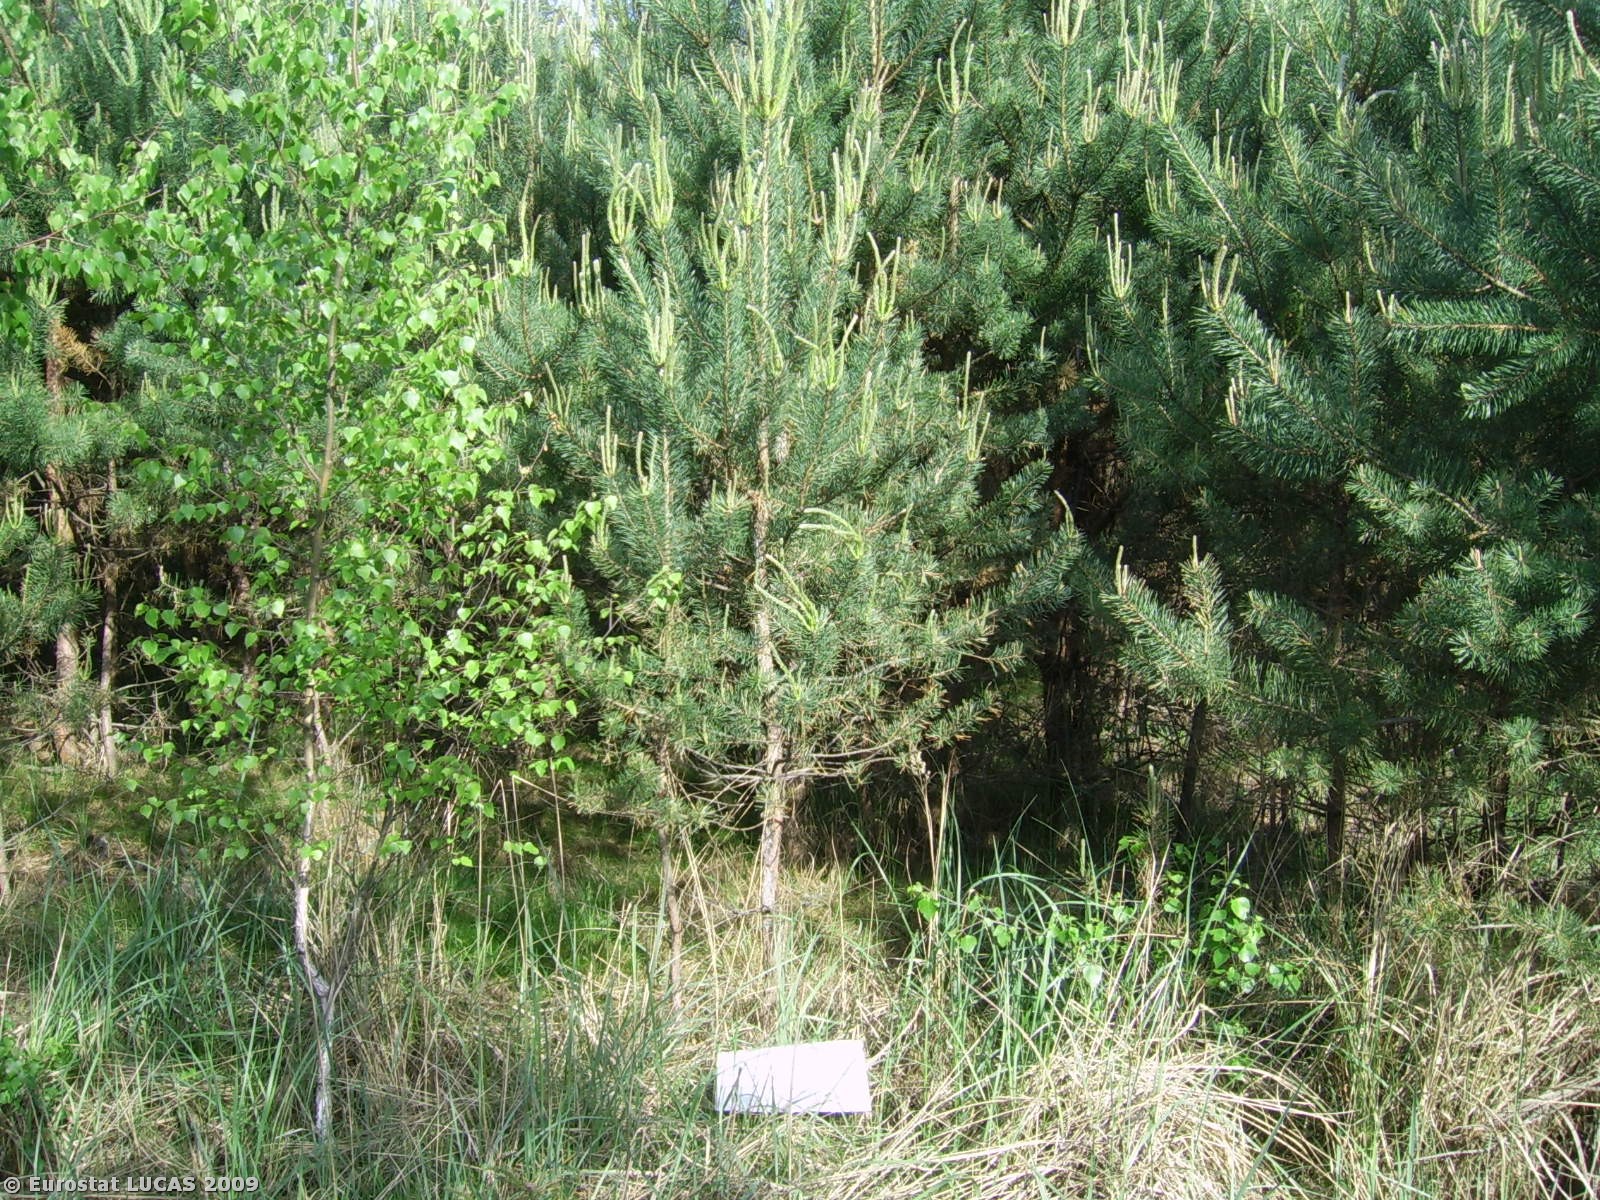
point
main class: Woodland
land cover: Mixed woodland
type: hemiboreal forest and nemoral coniferous forest and mixed broadleaved-coniferous forest
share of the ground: > 75 %
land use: Forestry
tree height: > 5 m
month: May
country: PL
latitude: 52.9795
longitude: 18.1931
